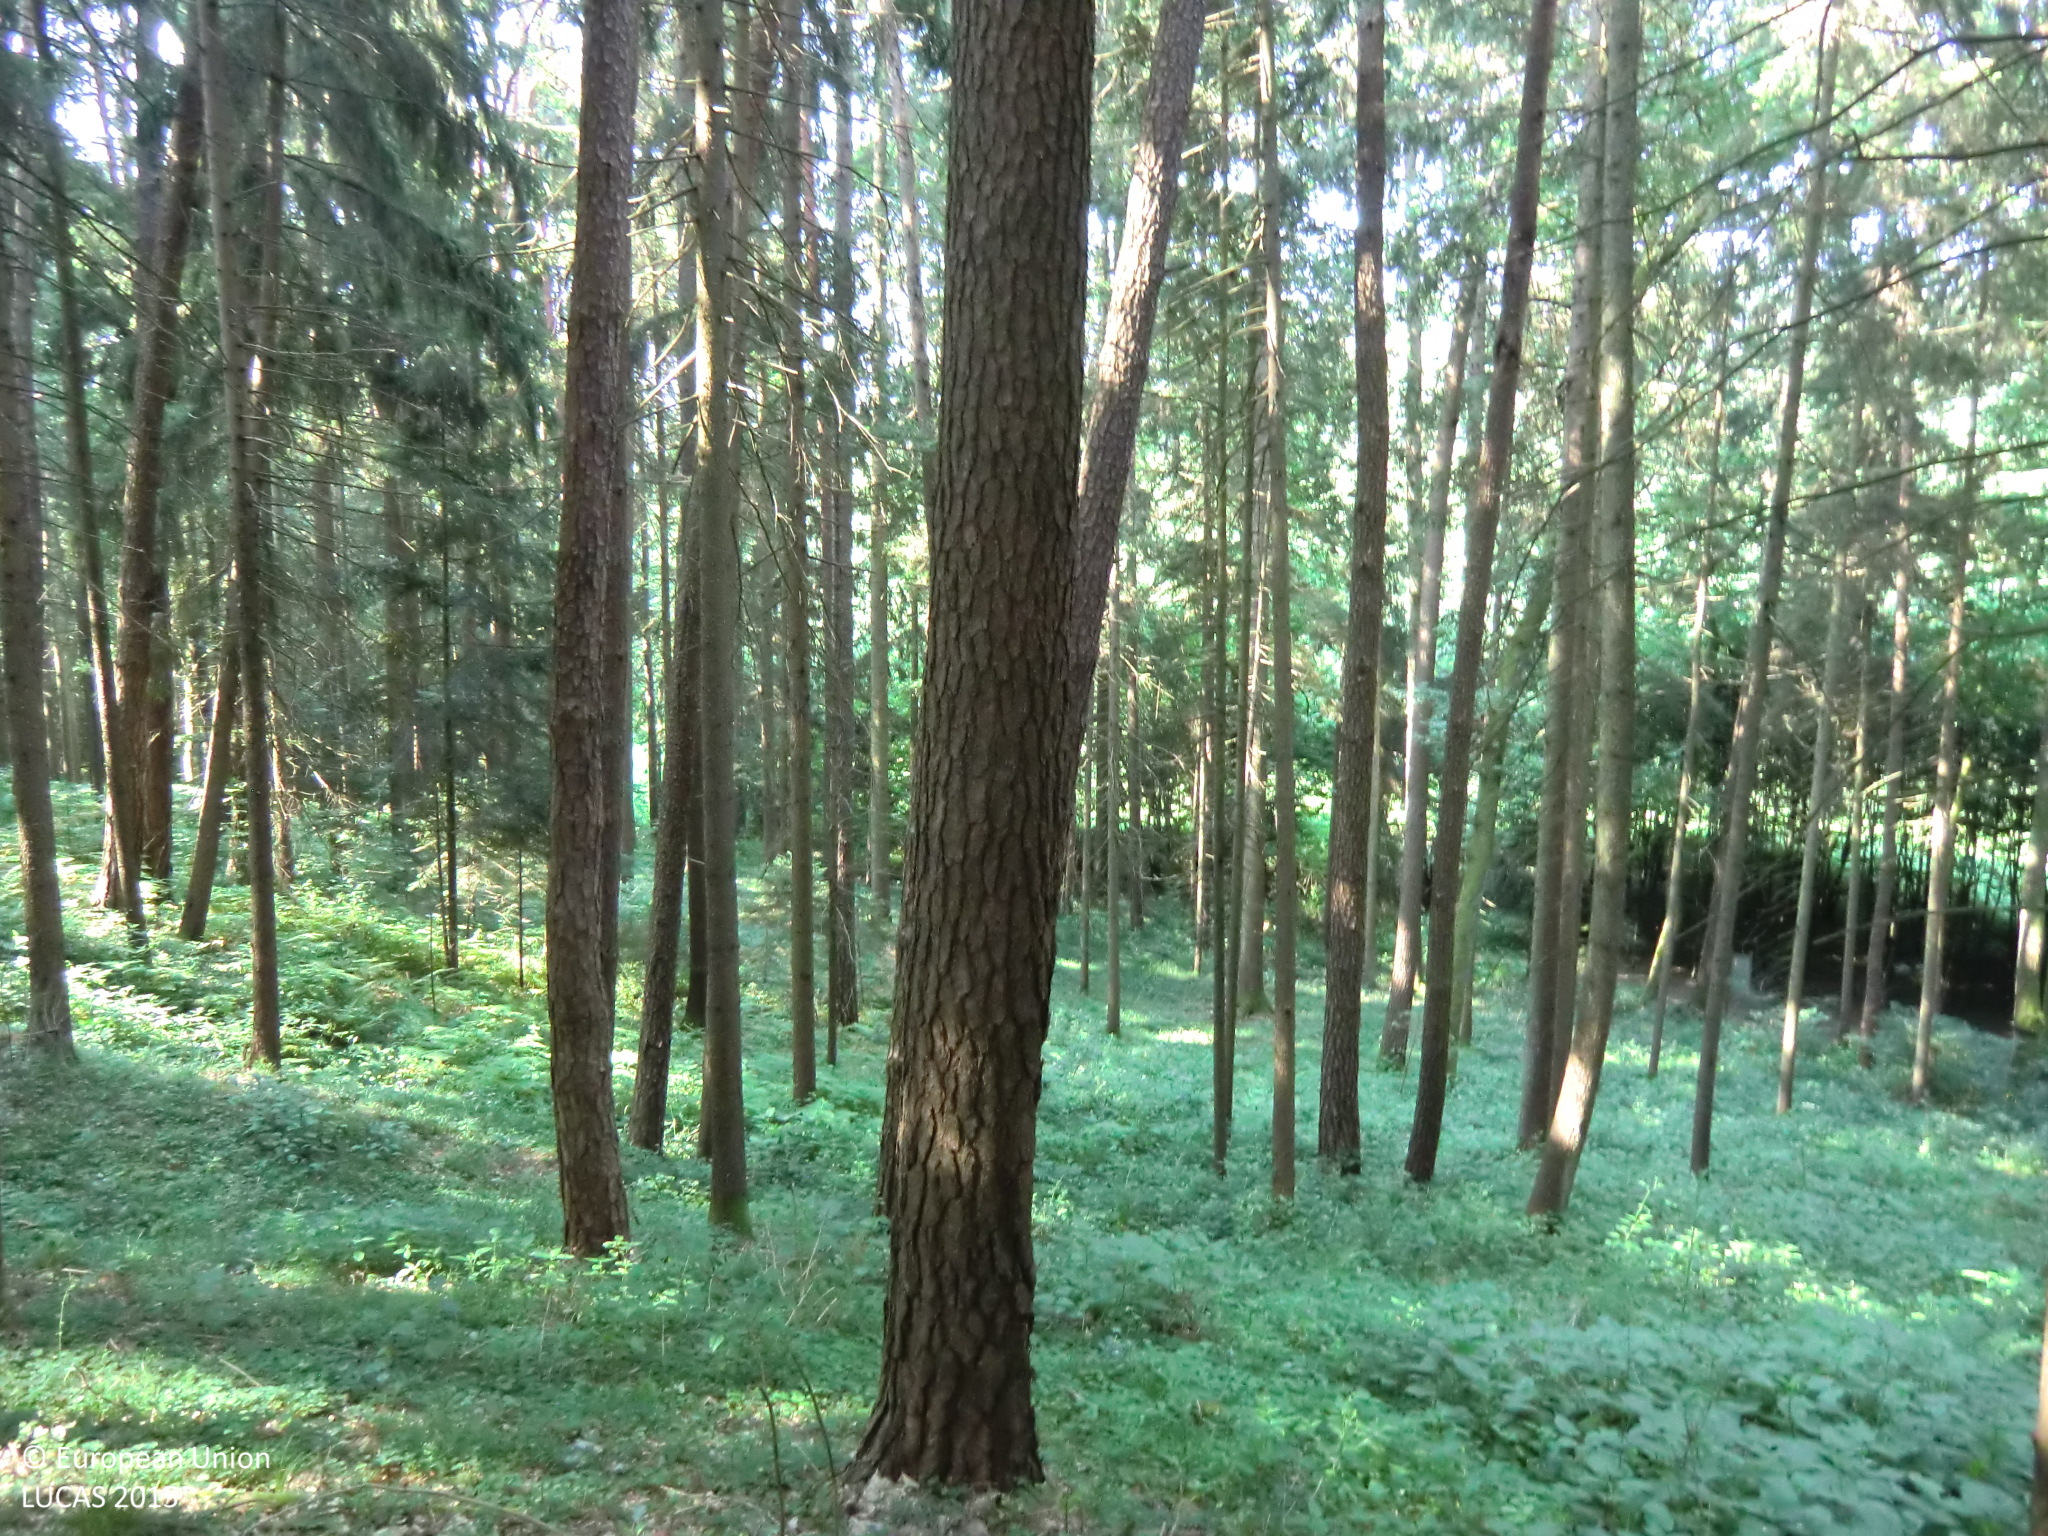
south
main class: Woodland
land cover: Other coniferous woodland
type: hemiboreal forest and nemoral coniferous forest and mixed broadleaved-coniferous forest
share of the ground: > 75 %
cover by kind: coniferous forest trees 75 %, broadleaved forest trees 10 %, herbaceous plants 10 %, unconsolidated bare surface 5 %
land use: Forestry
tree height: > 5 m
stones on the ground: < 10 %
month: July
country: AT
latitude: 47.1502
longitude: 16.1342
